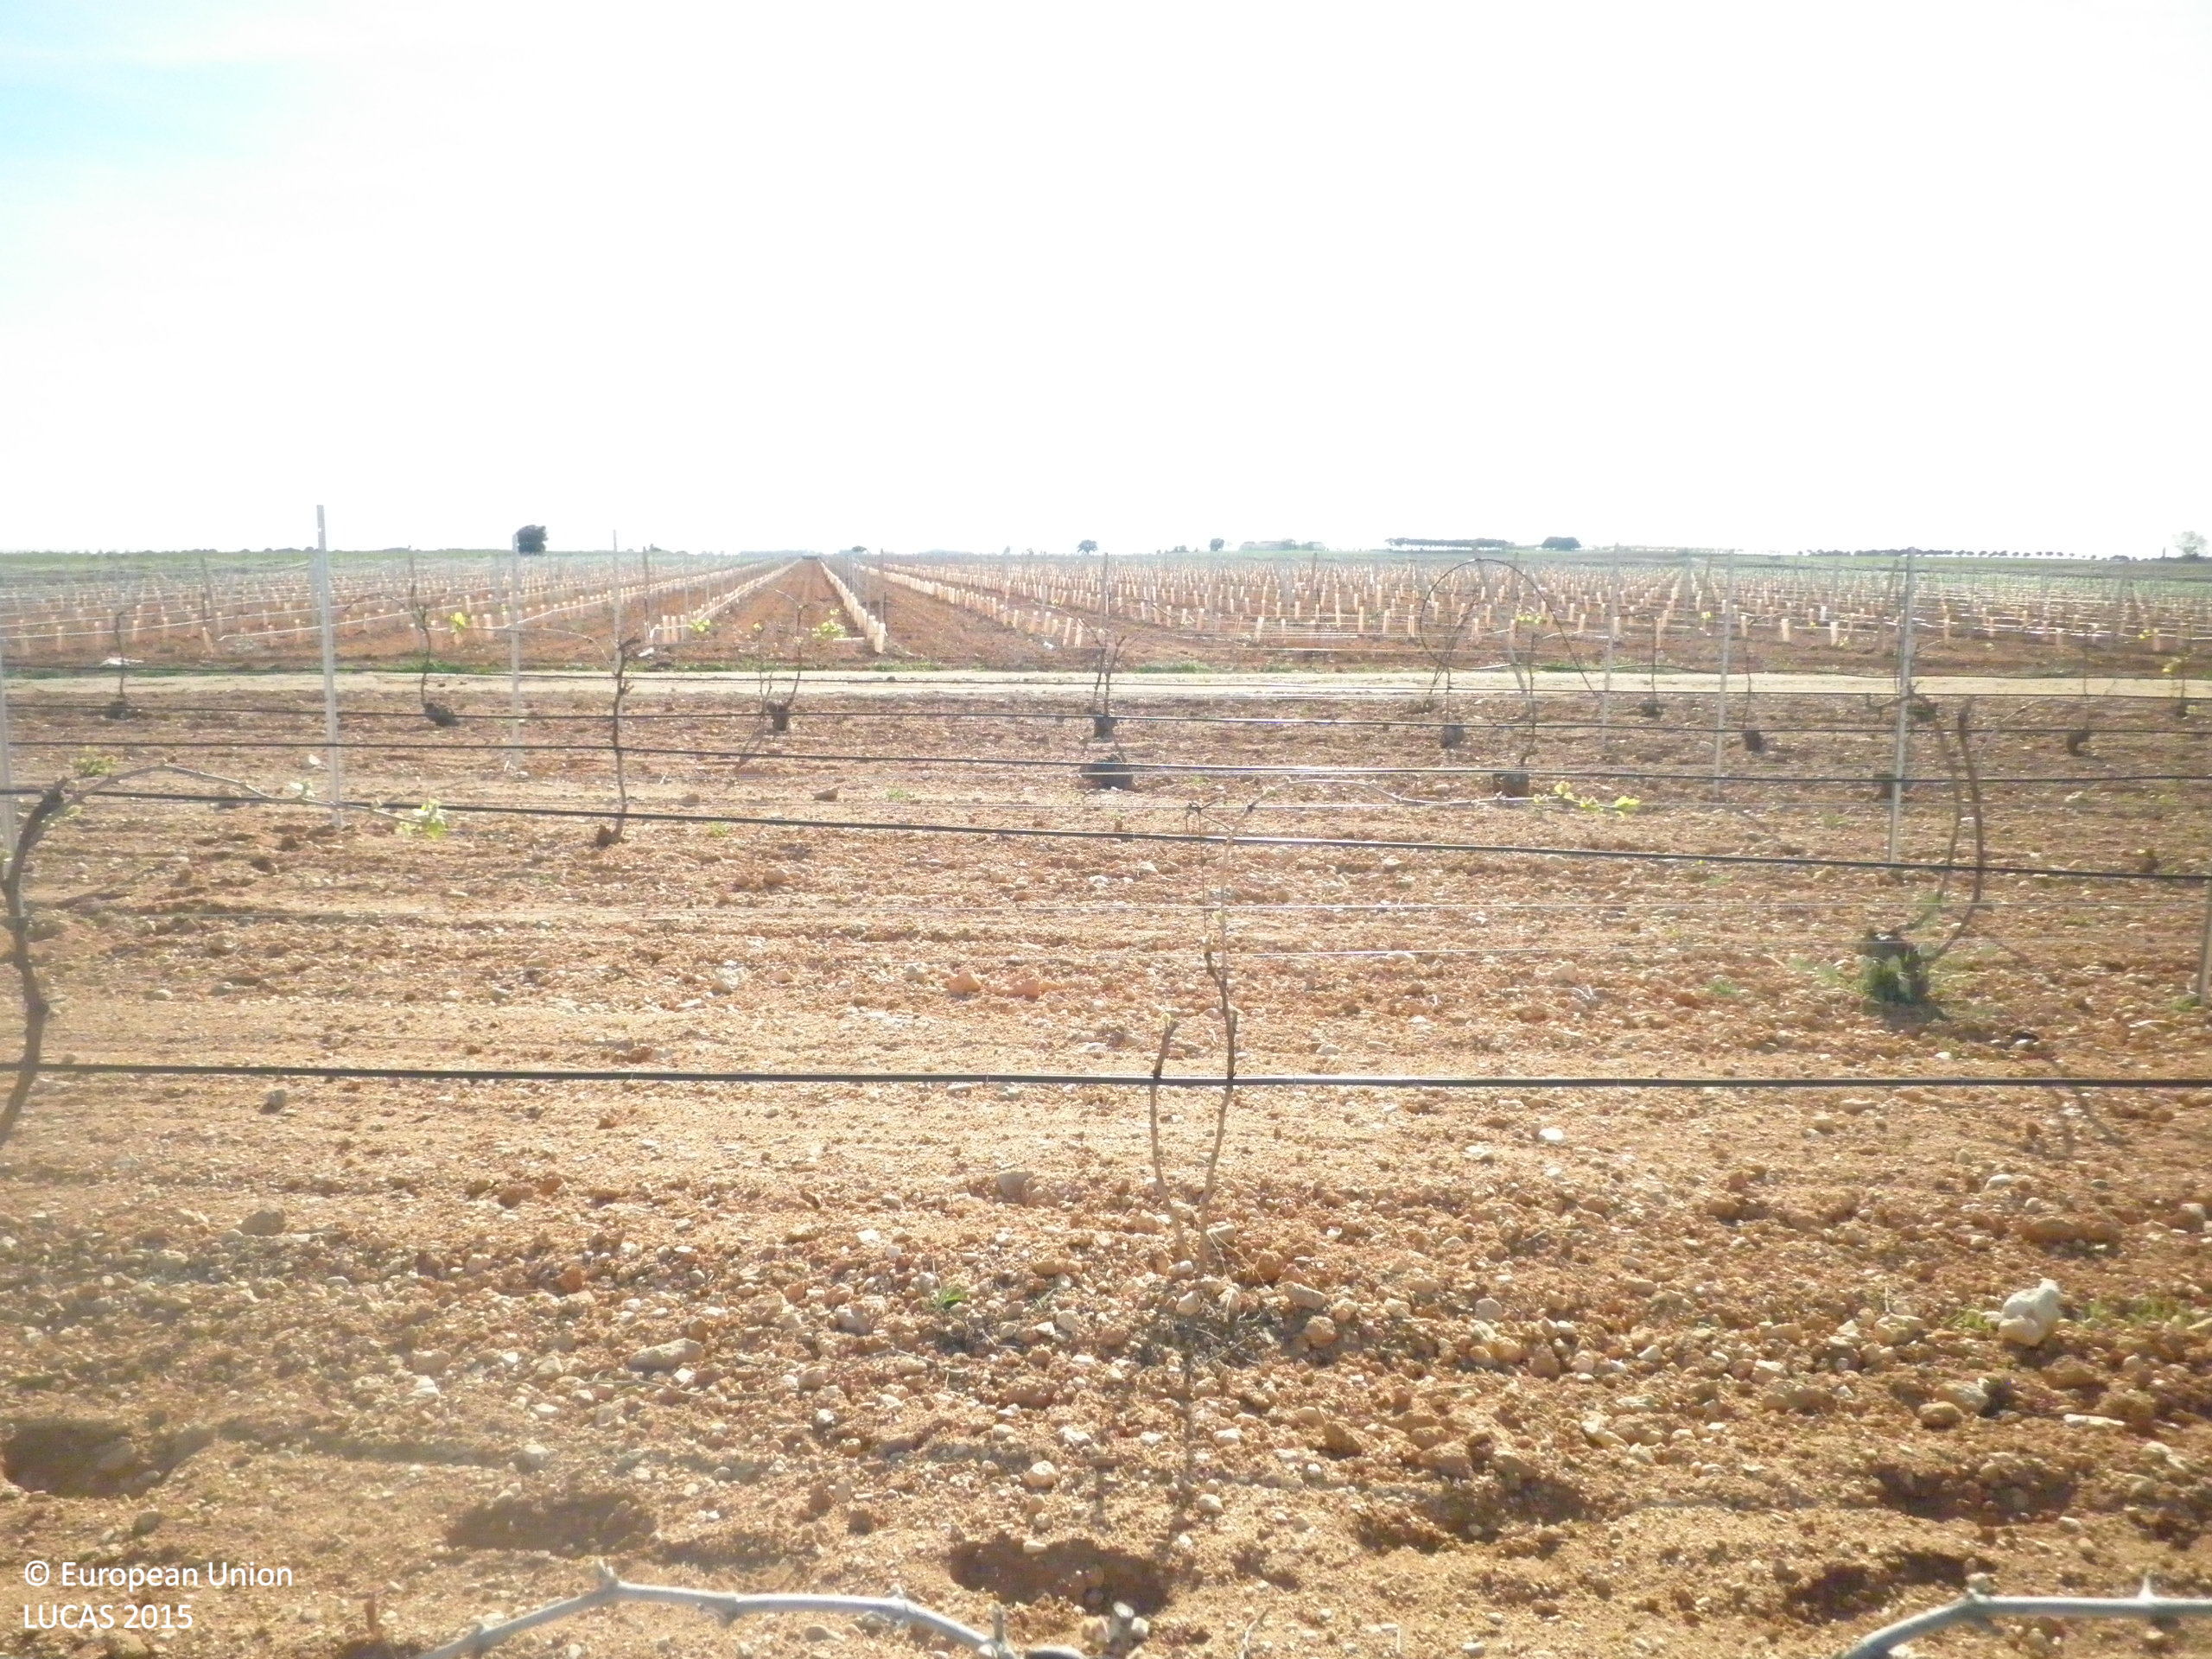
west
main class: Cropland
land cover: Vineyards
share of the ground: < 10 %
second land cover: Other bare soil
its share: > 75 %
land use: Agriculture (excluding fallow land and kitchen gardens)
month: April
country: ES
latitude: 39.3654
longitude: -2.6983
